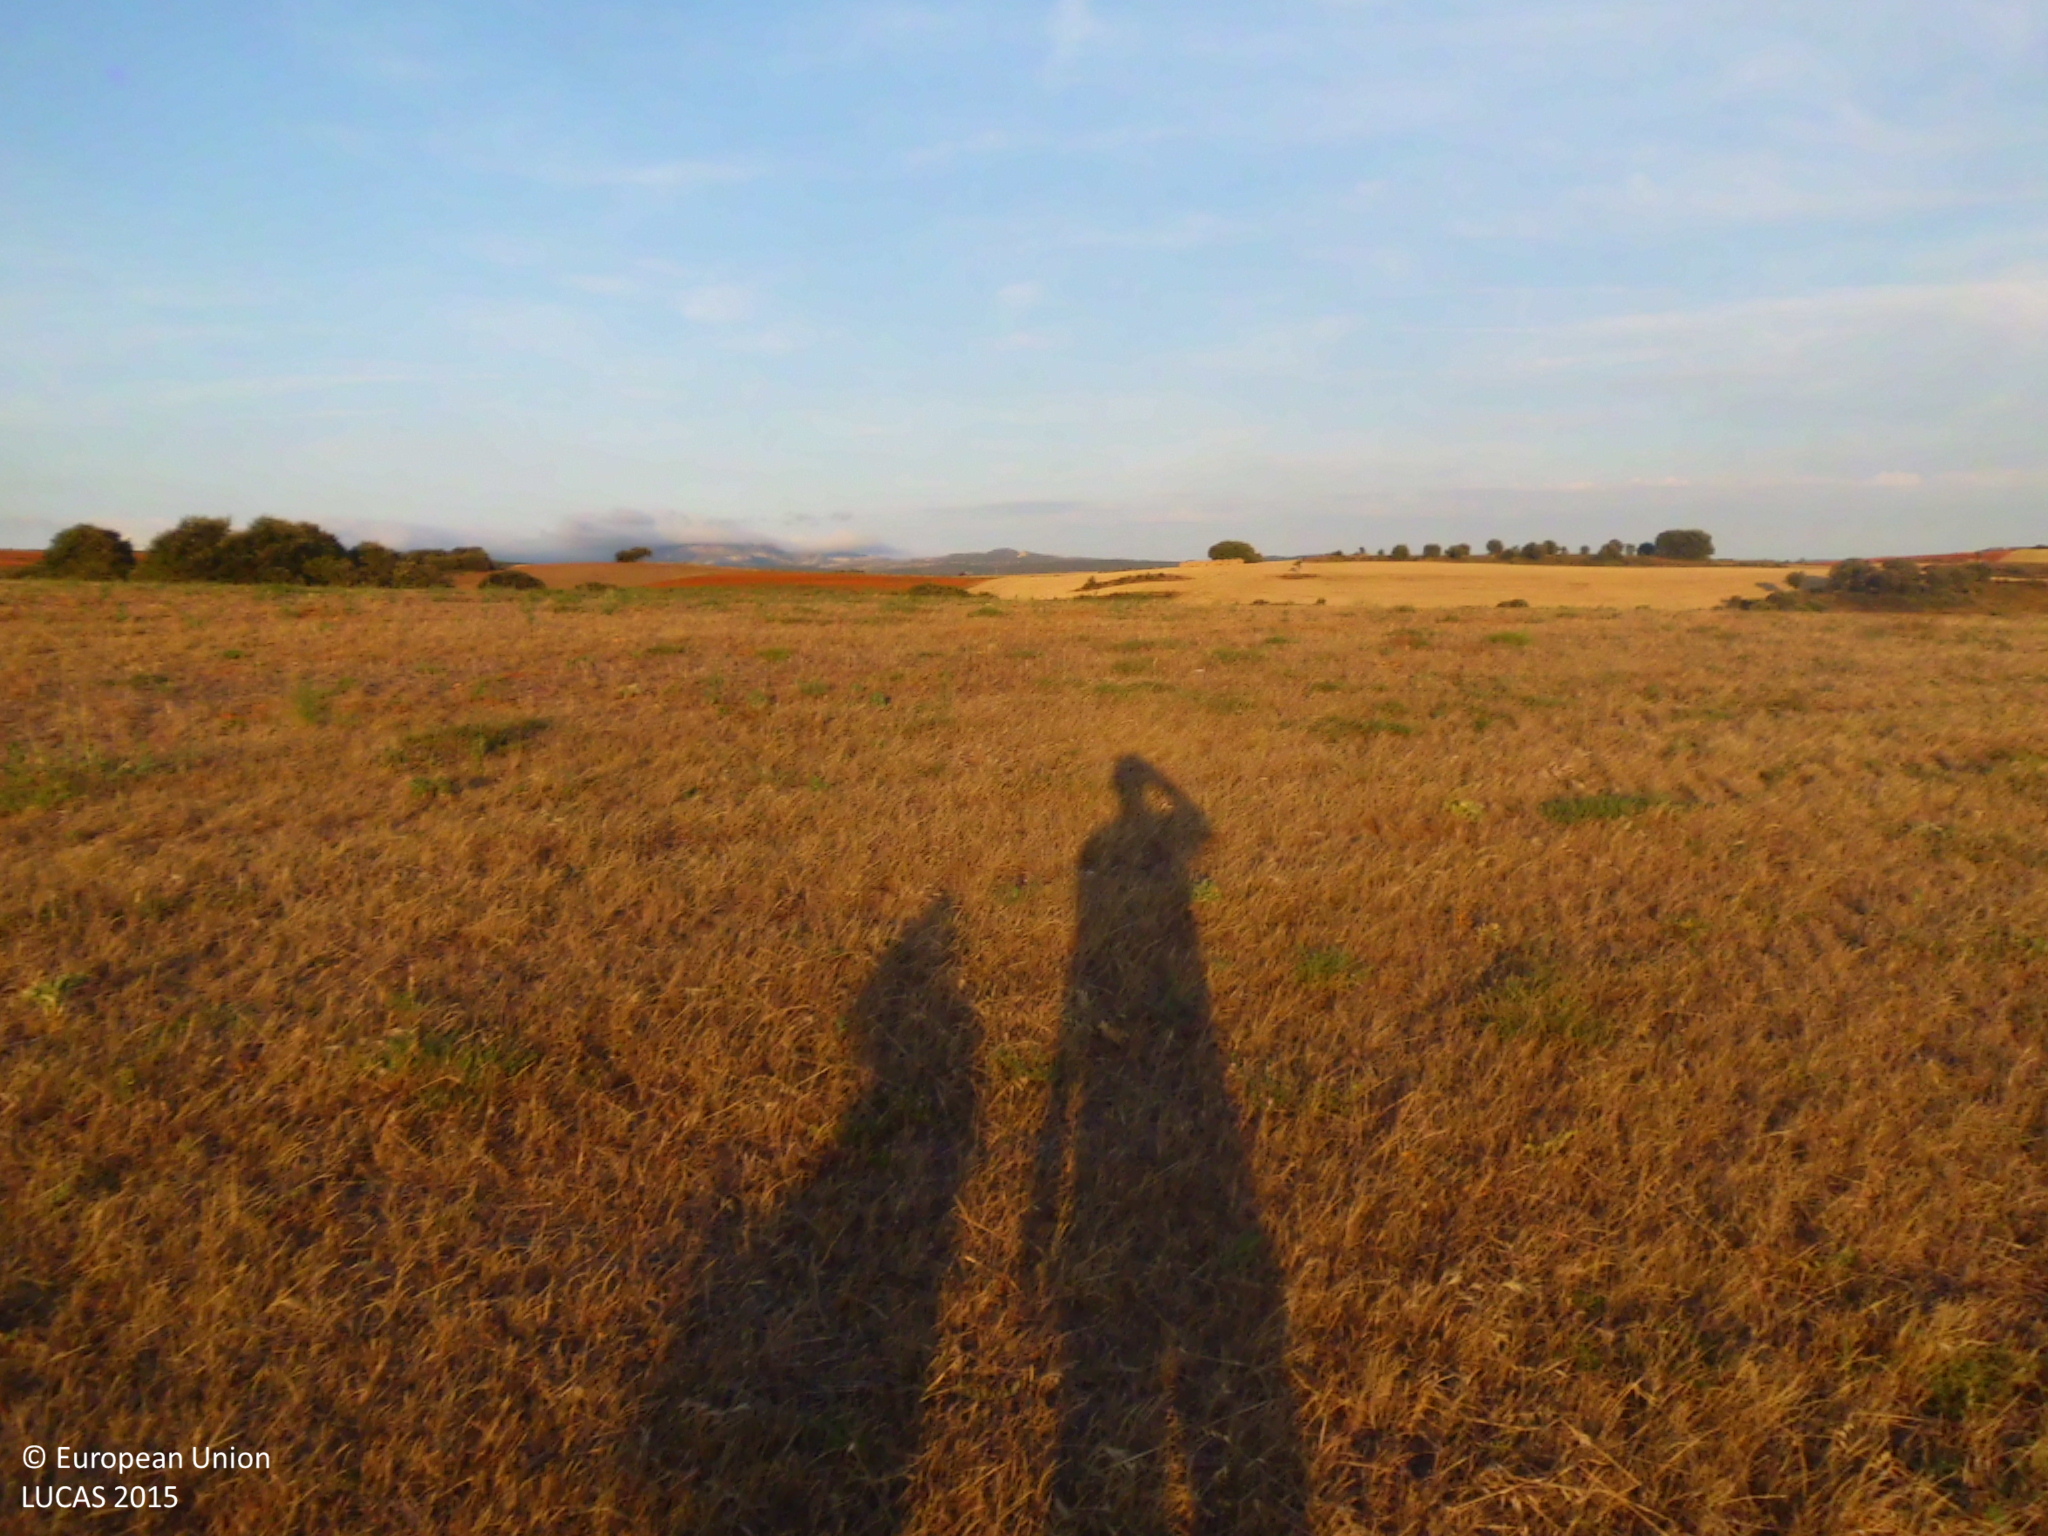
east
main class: Grassland
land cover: Spontaneously vegetated surfaces
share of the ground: > 75 %
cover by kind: herbaceous plants 100 %
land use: Fallow land
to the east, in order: Spontaneously vegetated surfaces; Shrubland with sparse tree cover; Common wheat; Grass margins; Barley
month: July
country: ES
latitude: 42.6824
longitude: -4.3909
